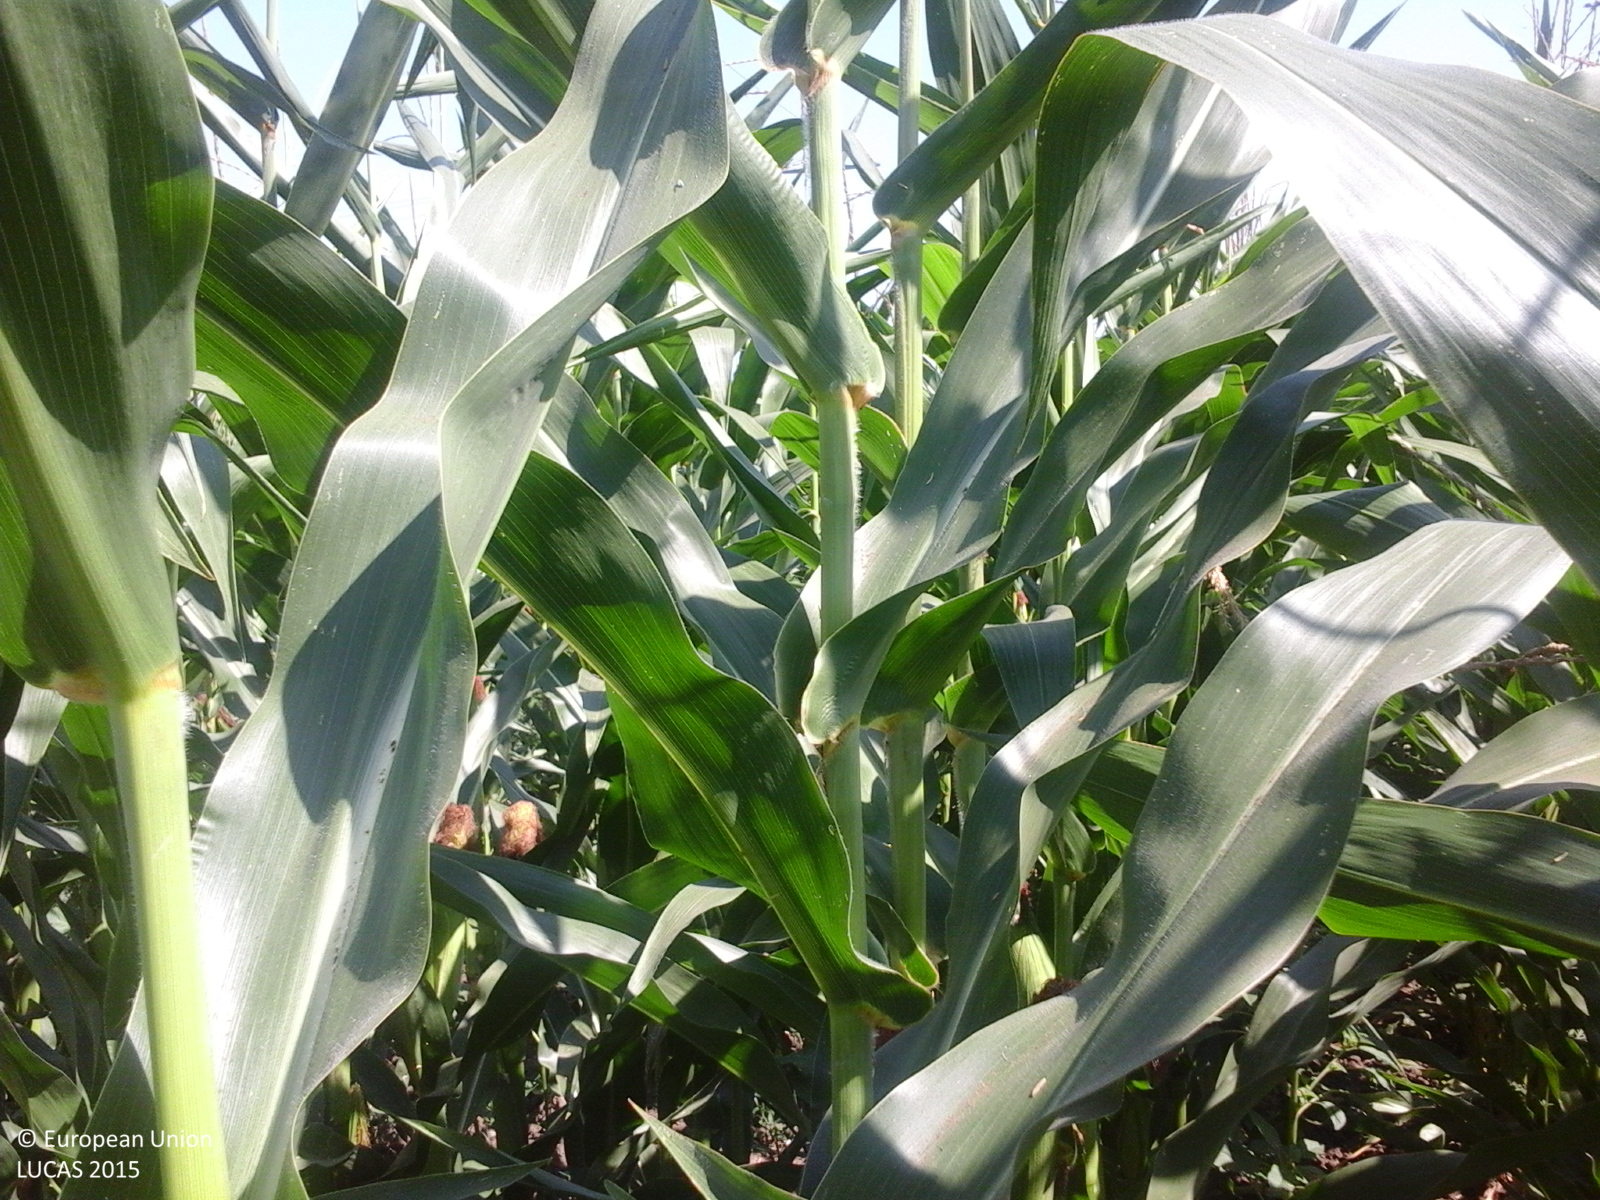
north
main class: Cropland
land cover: Maize
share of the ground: > 75 %
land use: Agriculture (excluding fallow land and kitchen gardens)
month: July
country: RO
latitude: 44.6592
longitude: 26.8102
